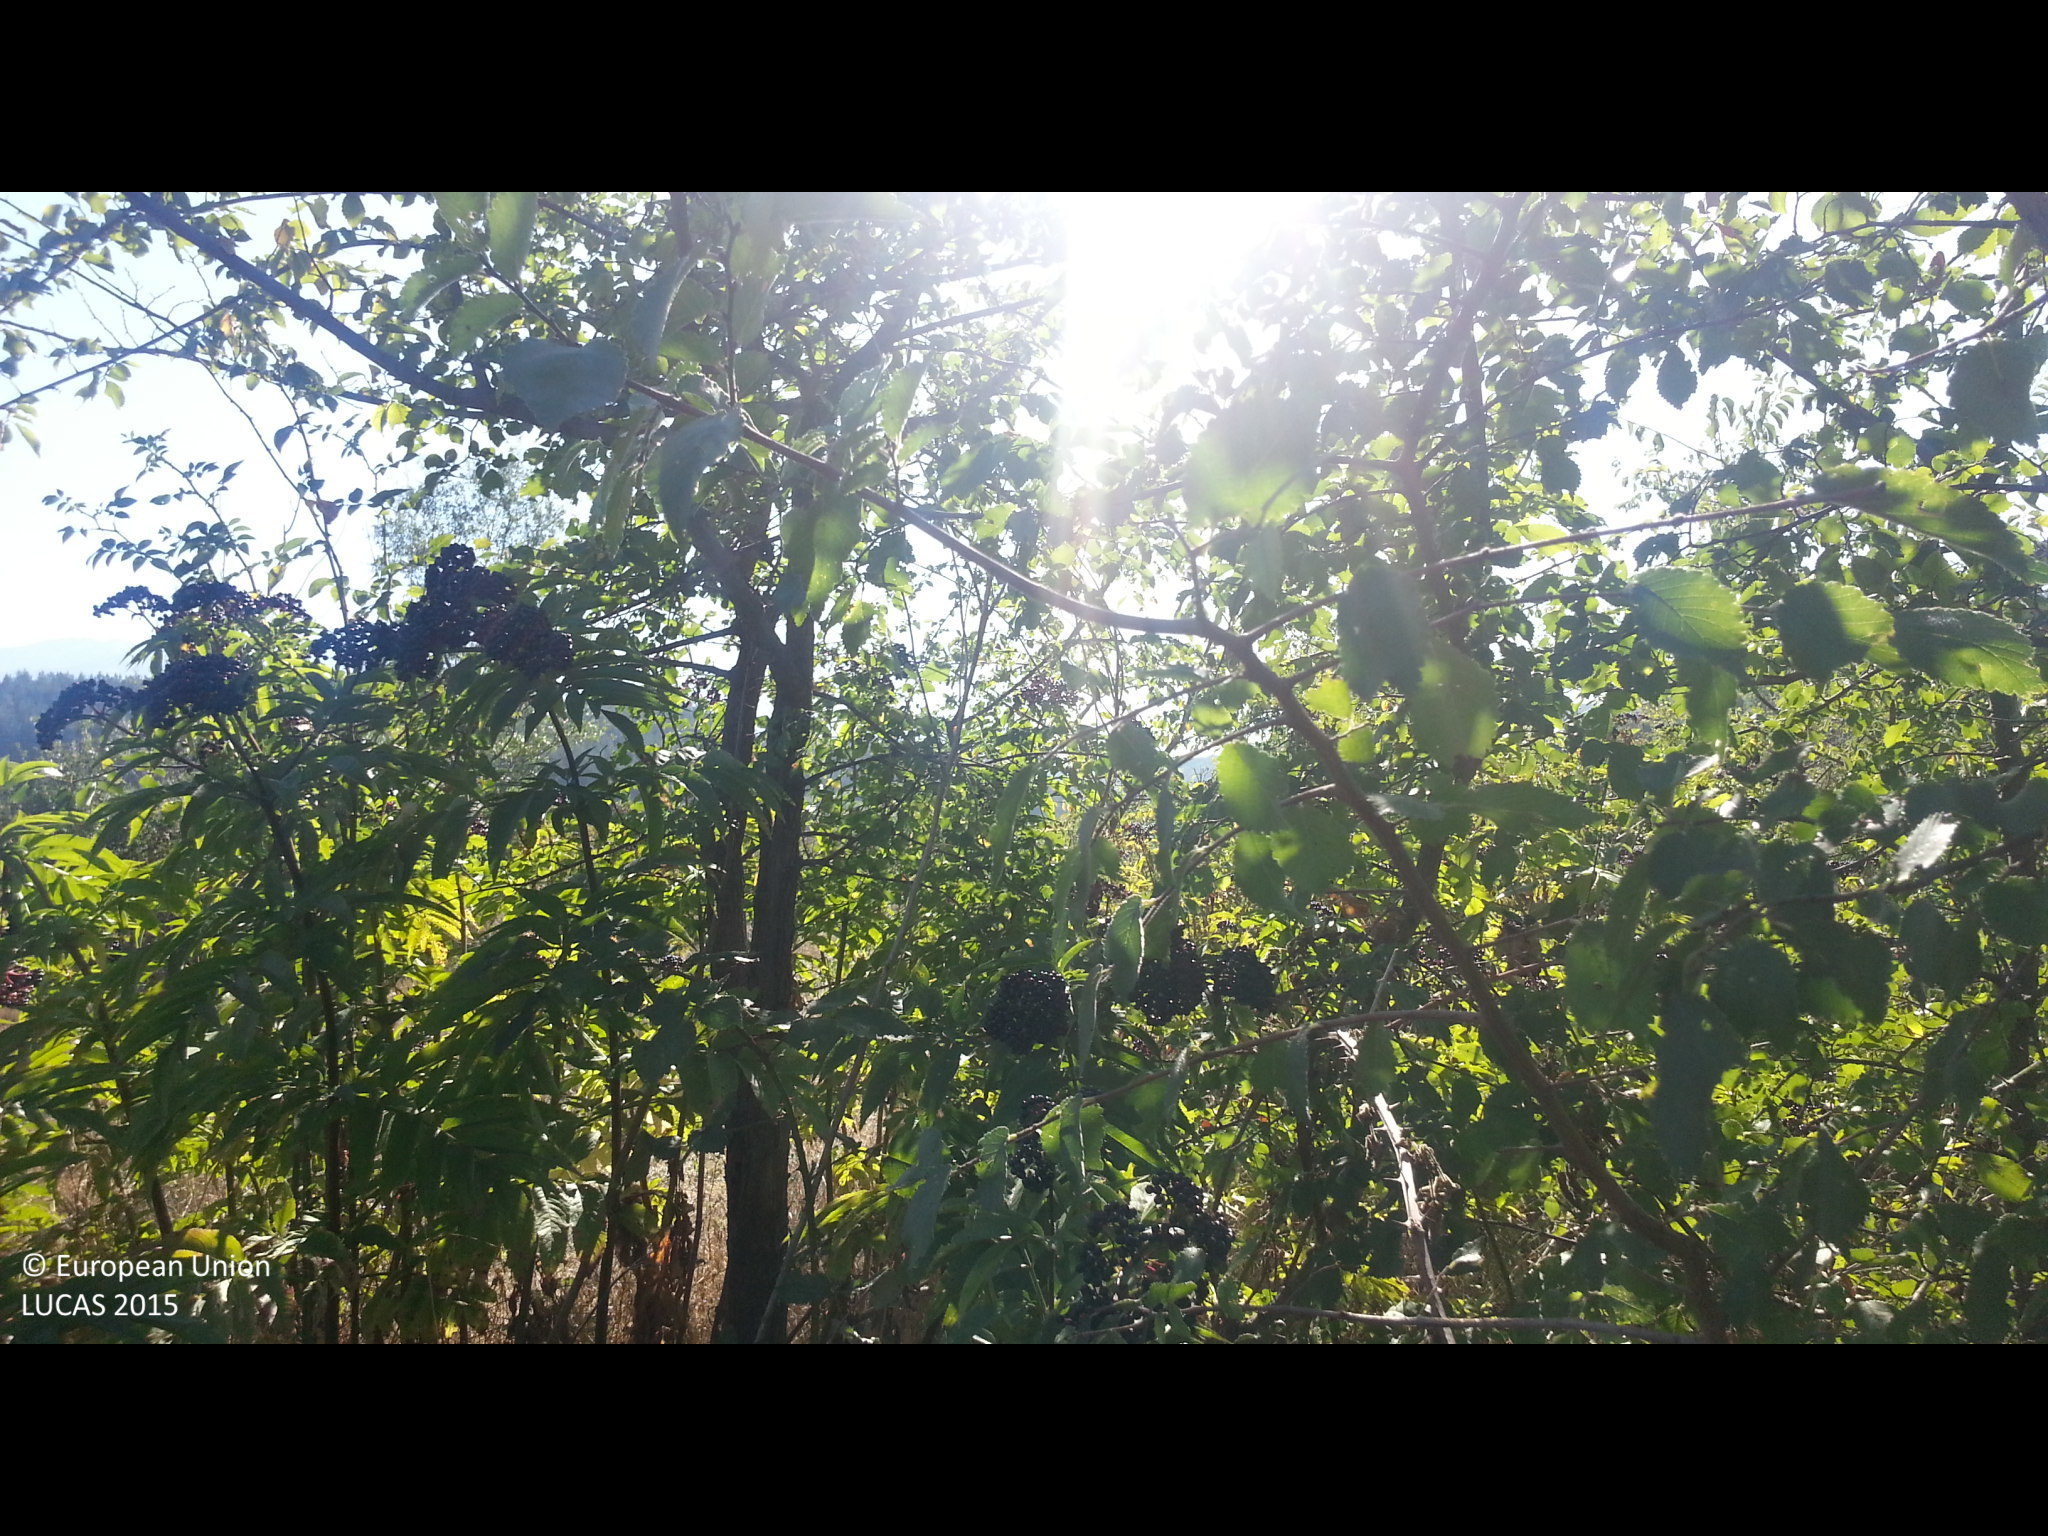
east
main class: Shrubland
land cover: Shrubland with sparse tree cover
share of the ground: > 75 %
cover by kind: shrubs 95 %, broadleaved forest trees 5 %
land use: Semi-natural and natural areas not in use
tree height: < 5 m
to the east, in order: Shrubland with sparse tree cover; Common wheat
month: September
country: BG
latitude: 42.1873
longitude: 23.0663
